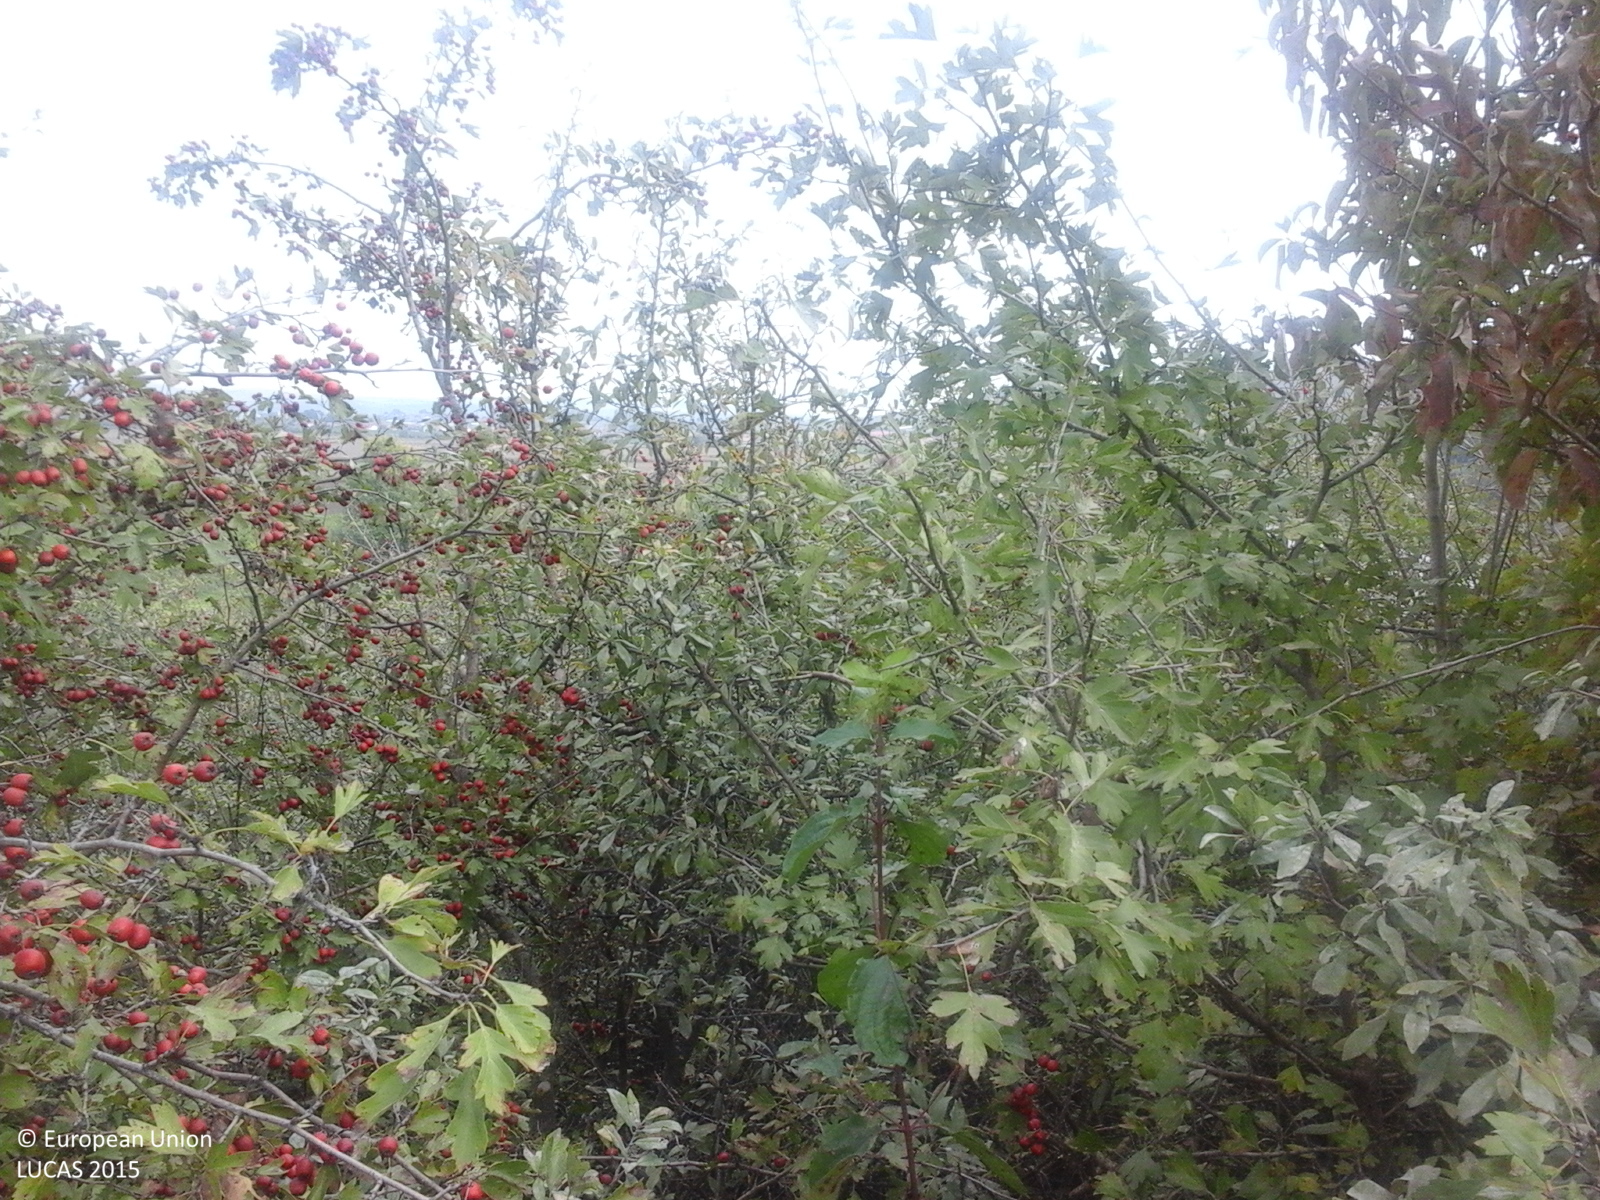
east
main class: Shrubland
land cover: Shrubland without tree cover
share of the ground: > 75 %
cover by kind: shrubs 100 %
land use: Semi-natural and natural areas not in use
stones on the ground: < 10 %
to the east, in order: Shrubland without tree cover; Grassland with sparse tree/shrub cover; Tracks; Grassland with sparse tree/shrub cover; Other bare soil; Inland fresh running water
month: October
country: RO
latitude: 46.4422
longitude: 24.0440
